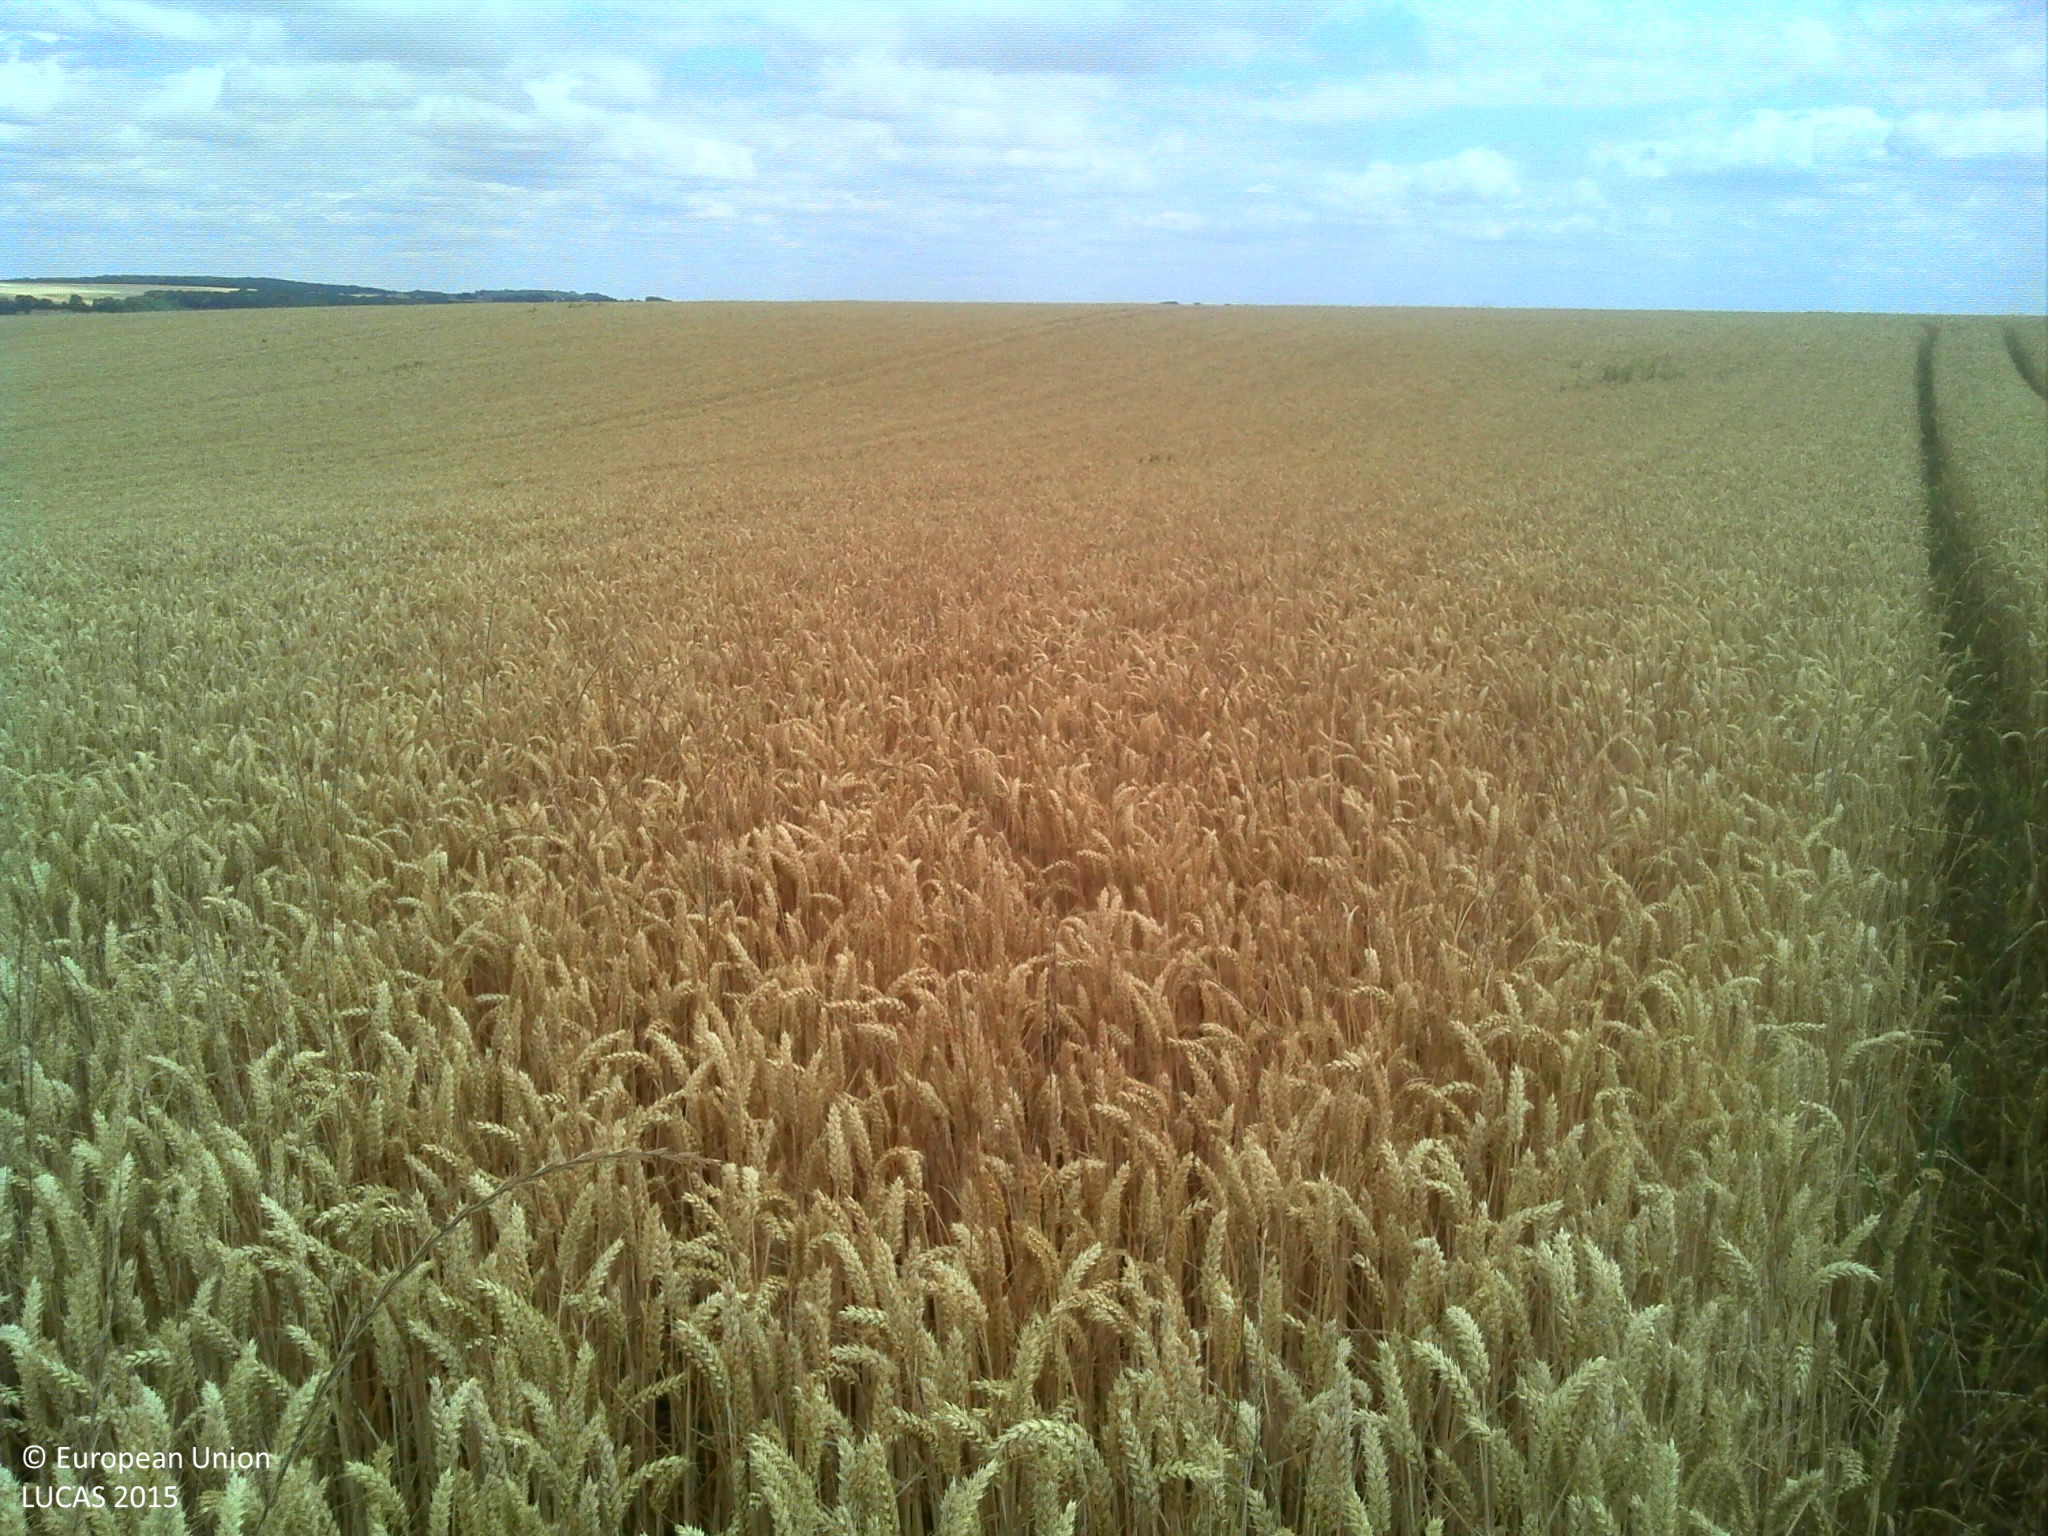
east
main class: Cropland
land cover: Common wheat
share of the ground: > 75 %
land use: Agriculture (excluding fallow land and kitchen gardens)
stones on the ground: < 10 %
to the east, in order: Common wheat; Grass margins; Tracks; Grass margins; Common wheat
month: July
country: FR
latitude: 49.2278
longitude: 3.2773
